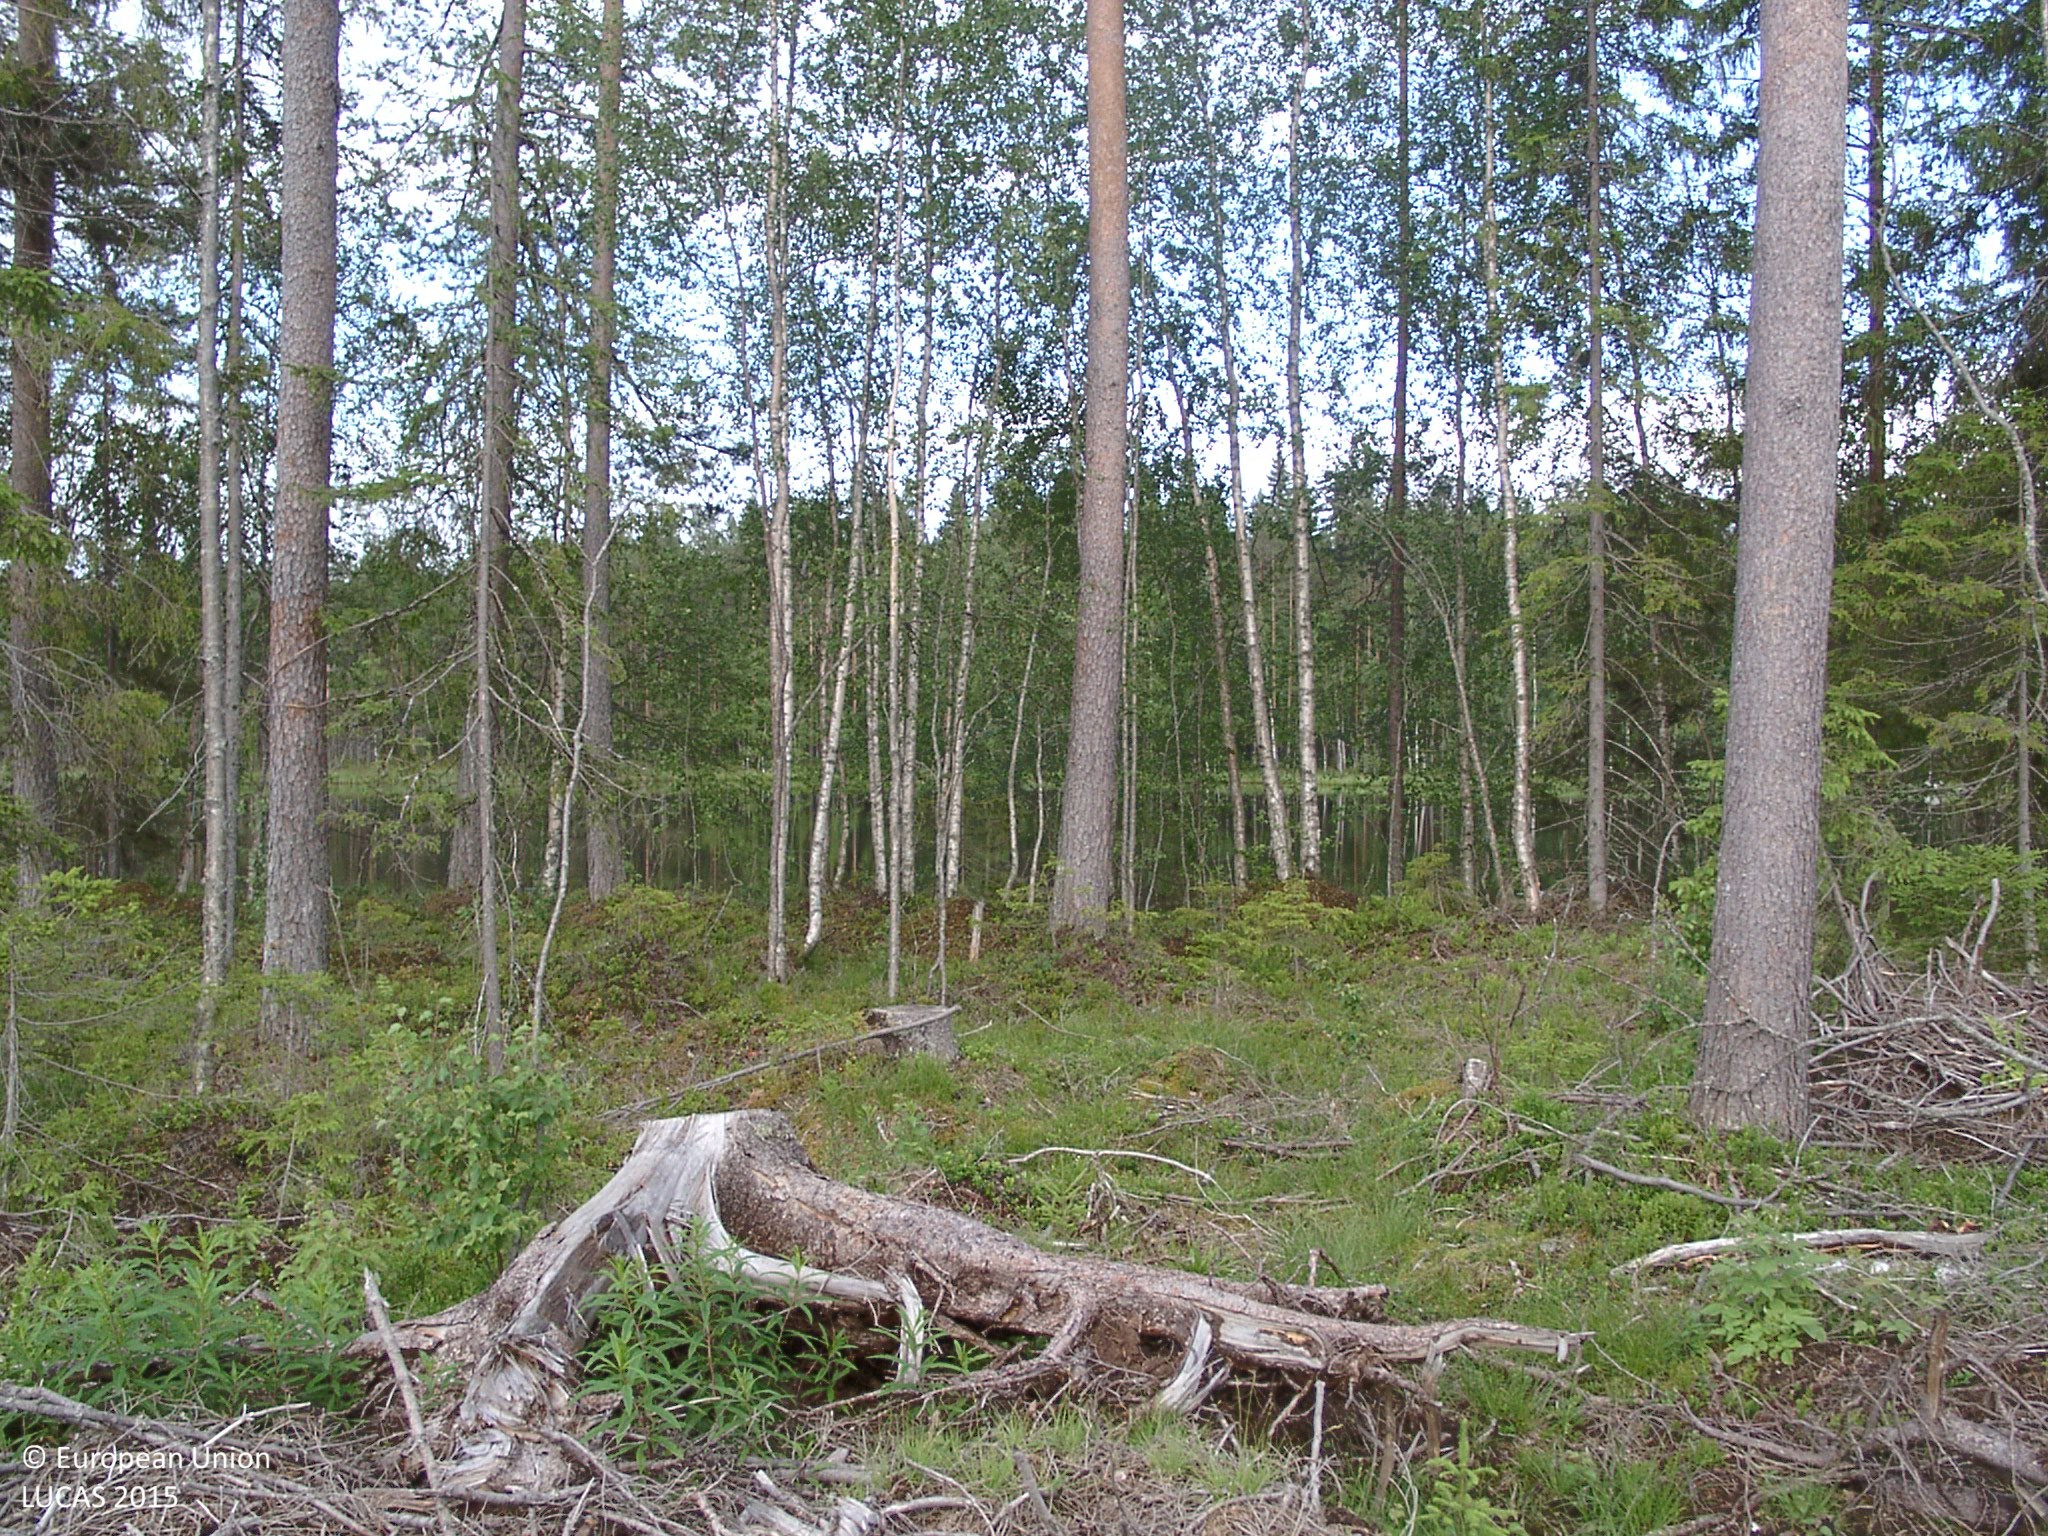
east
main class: Shrubland
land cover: Shrubland with sparse tree cover
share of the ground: 10 - 25 %
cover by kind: herbaceous plants 40 %, shrubs 15 %, broadleaved forest trees 5 %, unconsolidated bare surface 5 %
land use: Forestry
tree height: < 5 m
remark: Nursery
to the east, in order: Shrubland with sparse tree cover; Other mixed woodland; Inland fresh water bodies; Ponds and wetlands; Pine dominated coniferous woodland; Other mixed woodland; Ditches and canals; Other mixed woodland; Shruby margins; Pine dominated coniferous woodland
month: July
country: FI
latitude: 62.0783
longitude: 25.3304
